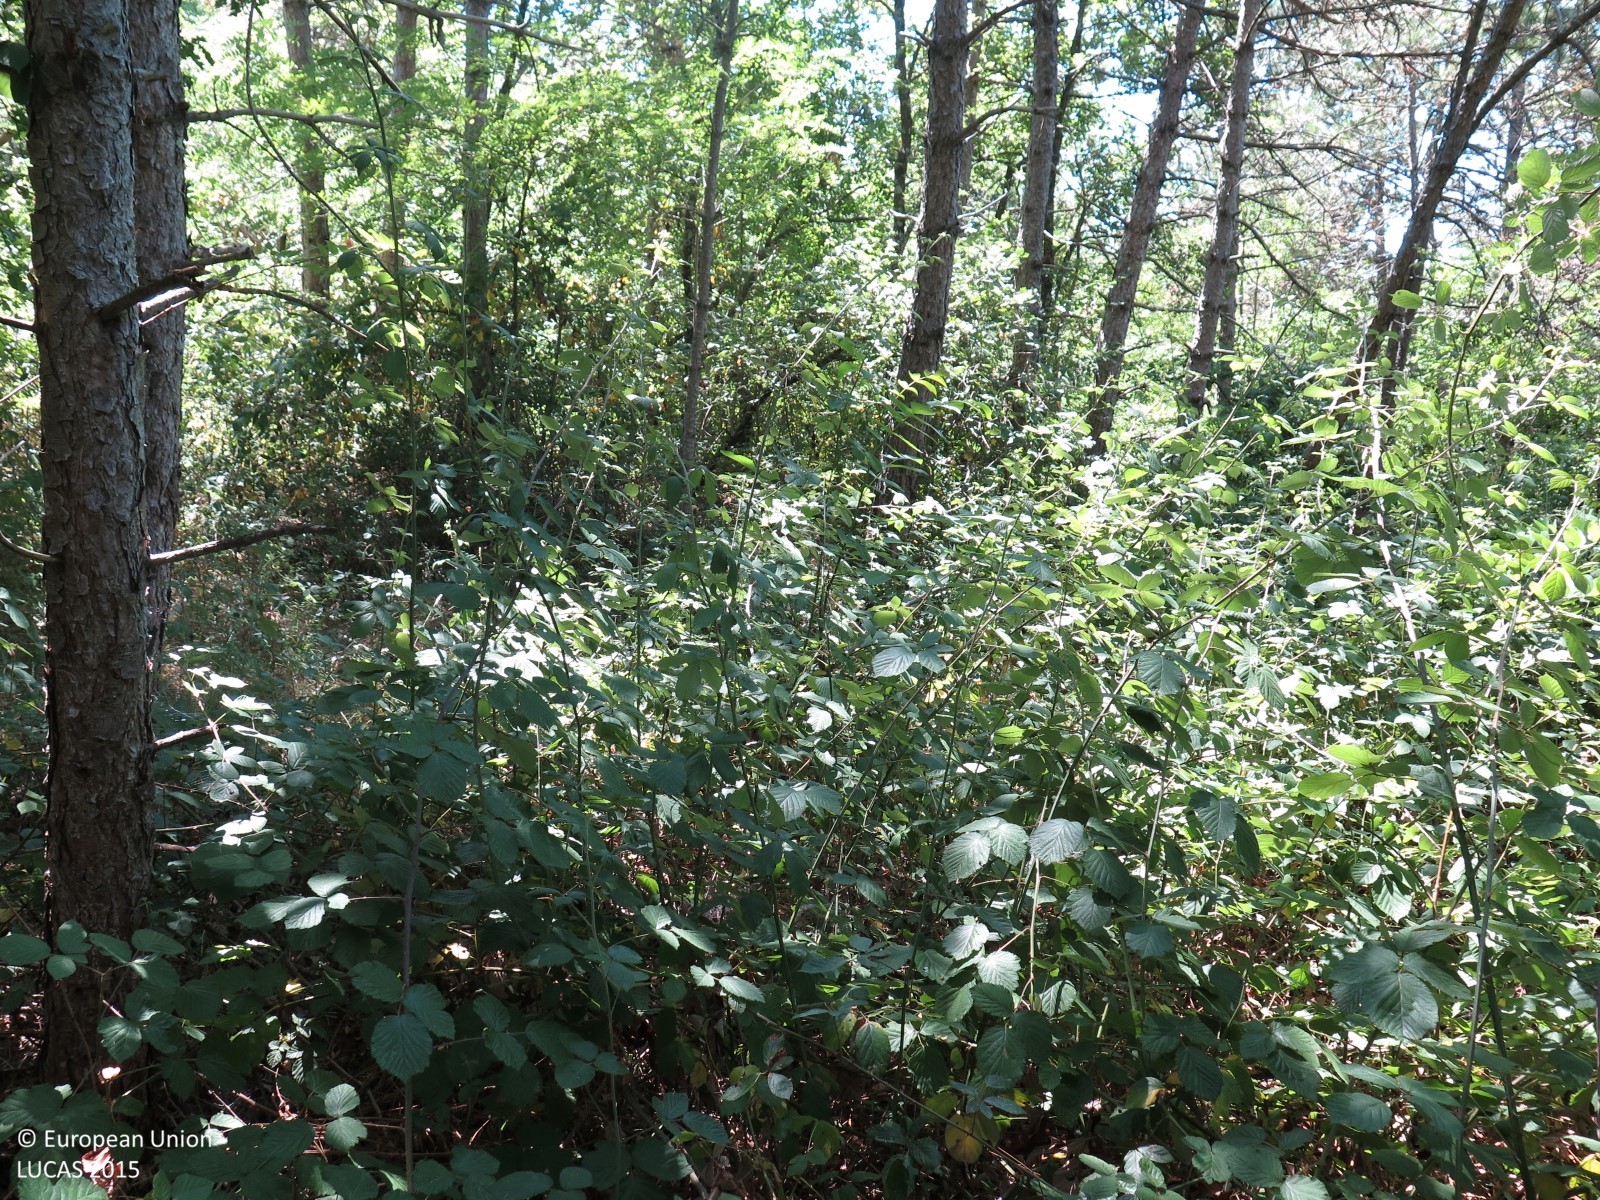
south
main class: Woodland
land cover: Pine dominated mixed woodland
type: coniferous forest of the mediterranean region
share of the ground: > 75 %
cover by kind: coniferous forest trees 75 %, broadleaved forest trees 25 %
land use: Semi-natural and natural areas not in use
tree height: > 5 m
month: July
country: HR
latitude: 45.3976
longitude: 13.8658
